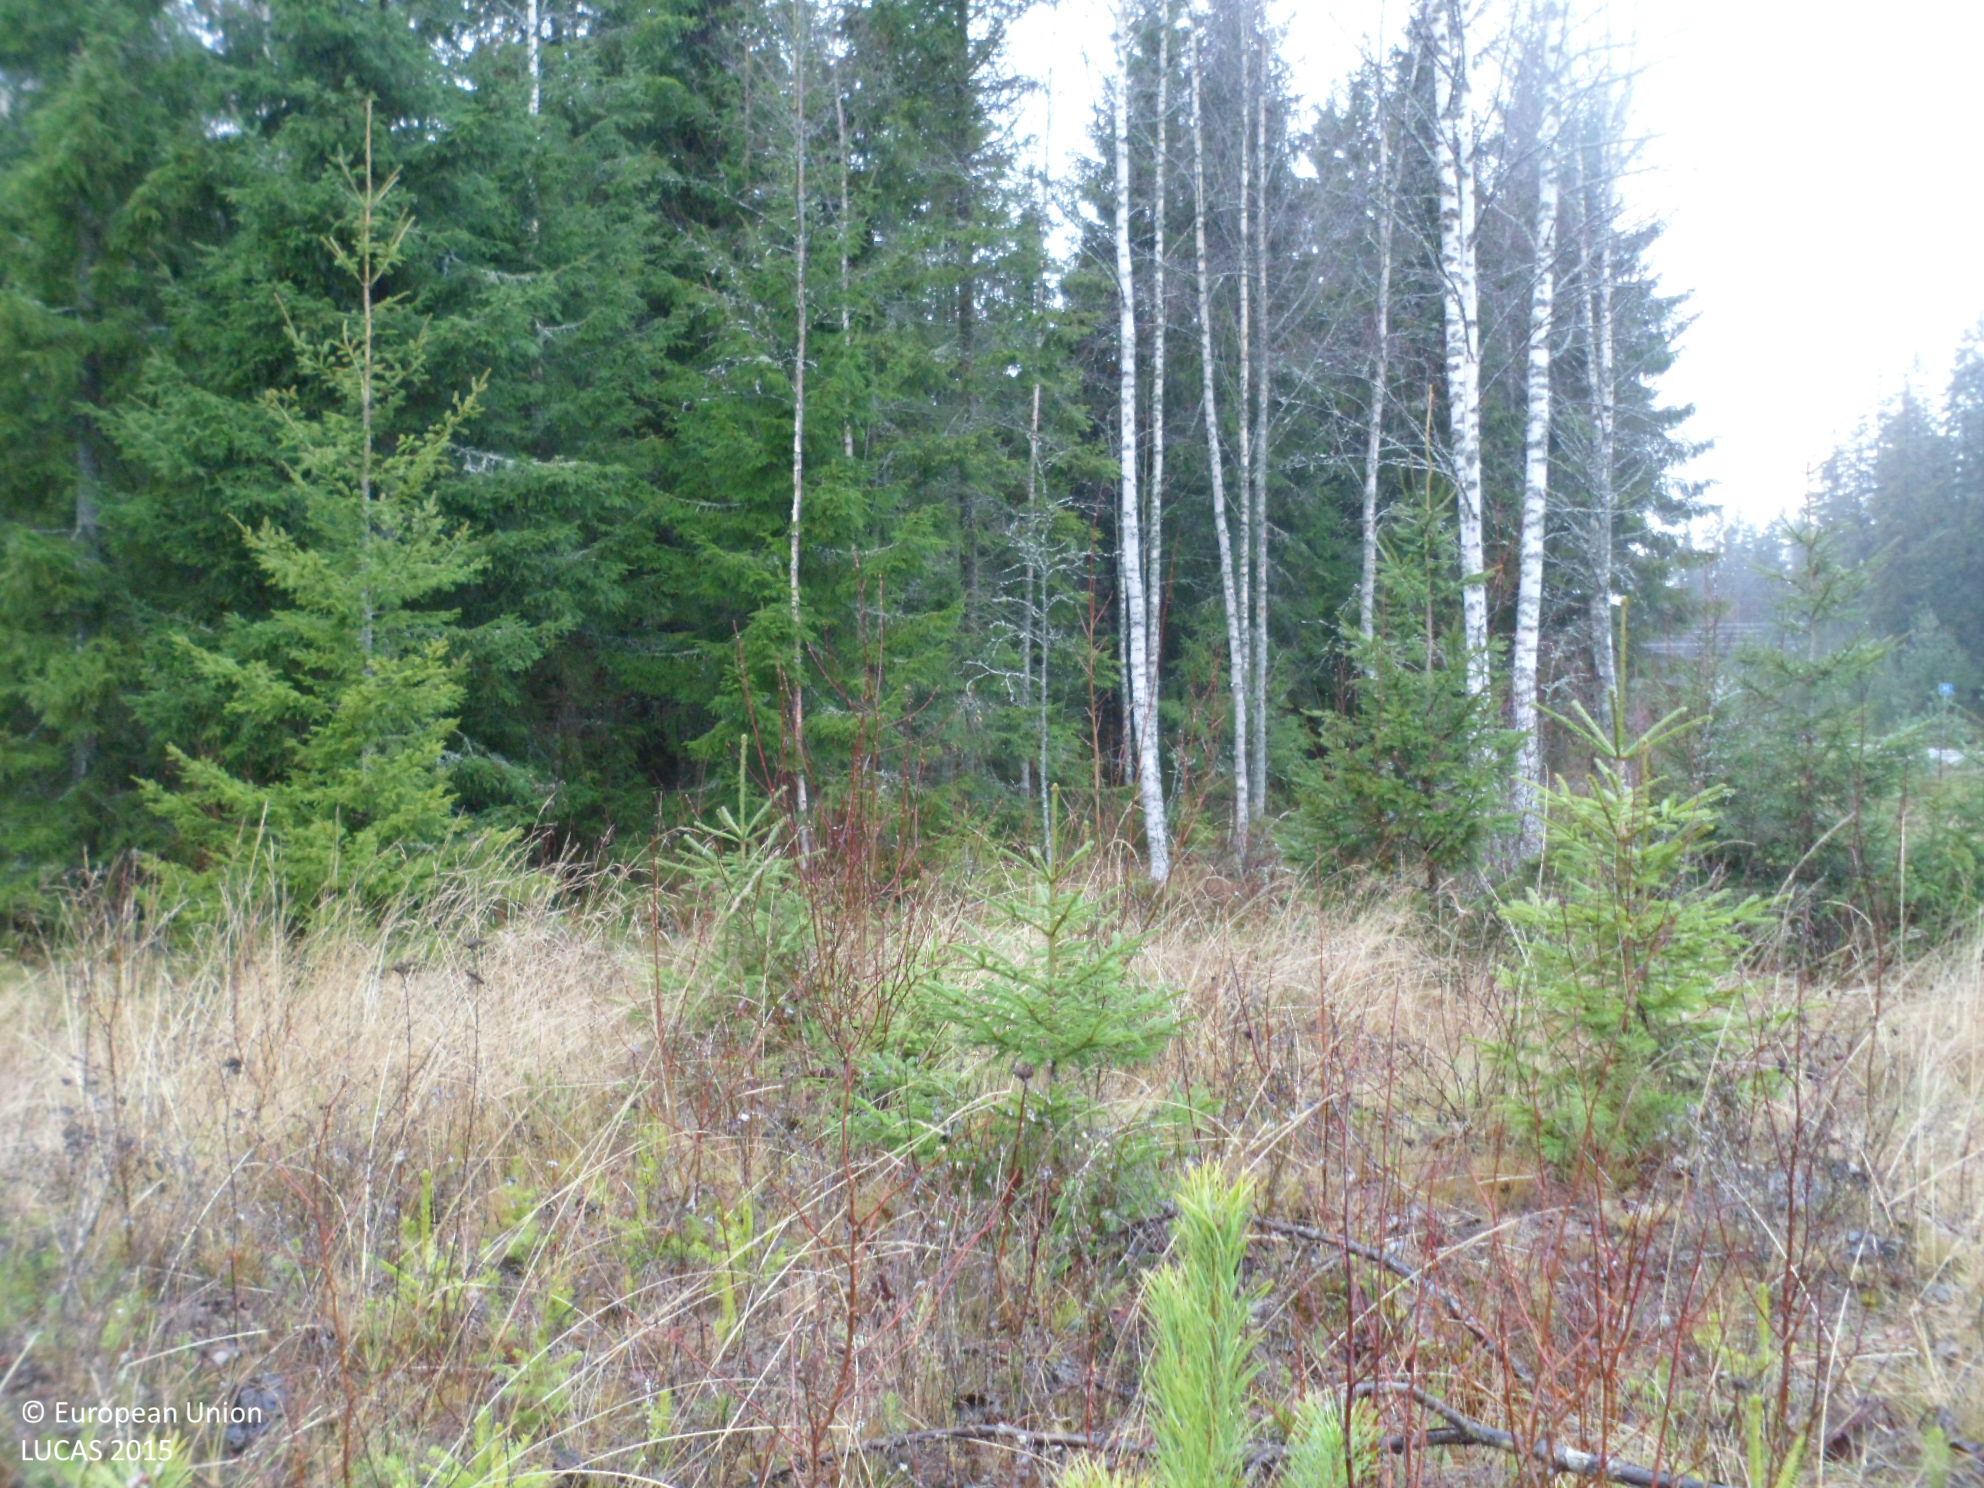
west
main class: Woodland
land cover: Broadleaved woodland
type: boreal forest
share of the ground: 50 - 75 %
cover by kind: broadleaved forest trees 55 %, herbaceous plants 30 %, shrubs 15 %
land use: Electricity, gas and thermal power distribution
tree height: < 5 m
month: November
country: SE
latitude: 57.7560
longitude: 14.7848
